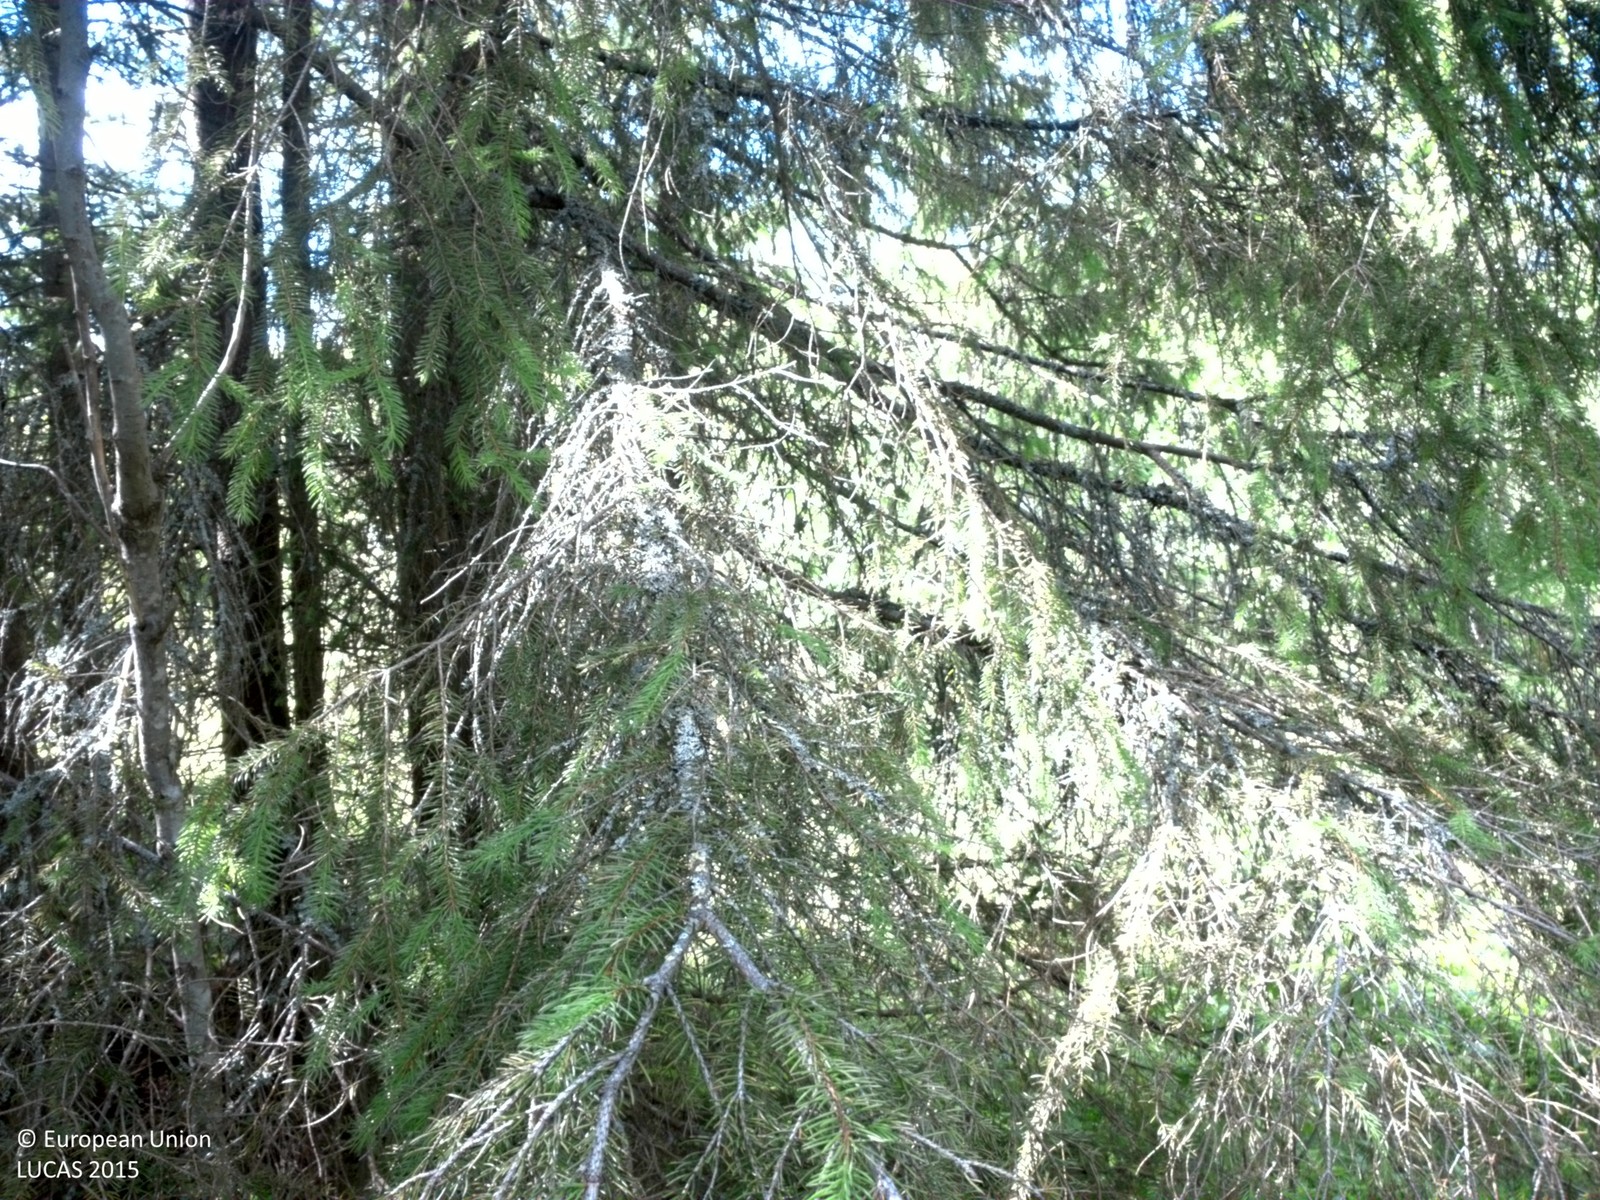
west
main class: Woodland
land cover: Spruce dominated mixed woodland
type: boreal forest
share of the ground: > 75 %
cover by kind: coniferous forest trees 60 %, broadleaved forest trees 20 %, shrubs 10 %, herbaceous plants 10 %
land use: Forestry
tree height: > 5 m
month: July
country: SE
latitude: 64.3800
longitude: 20.7377
